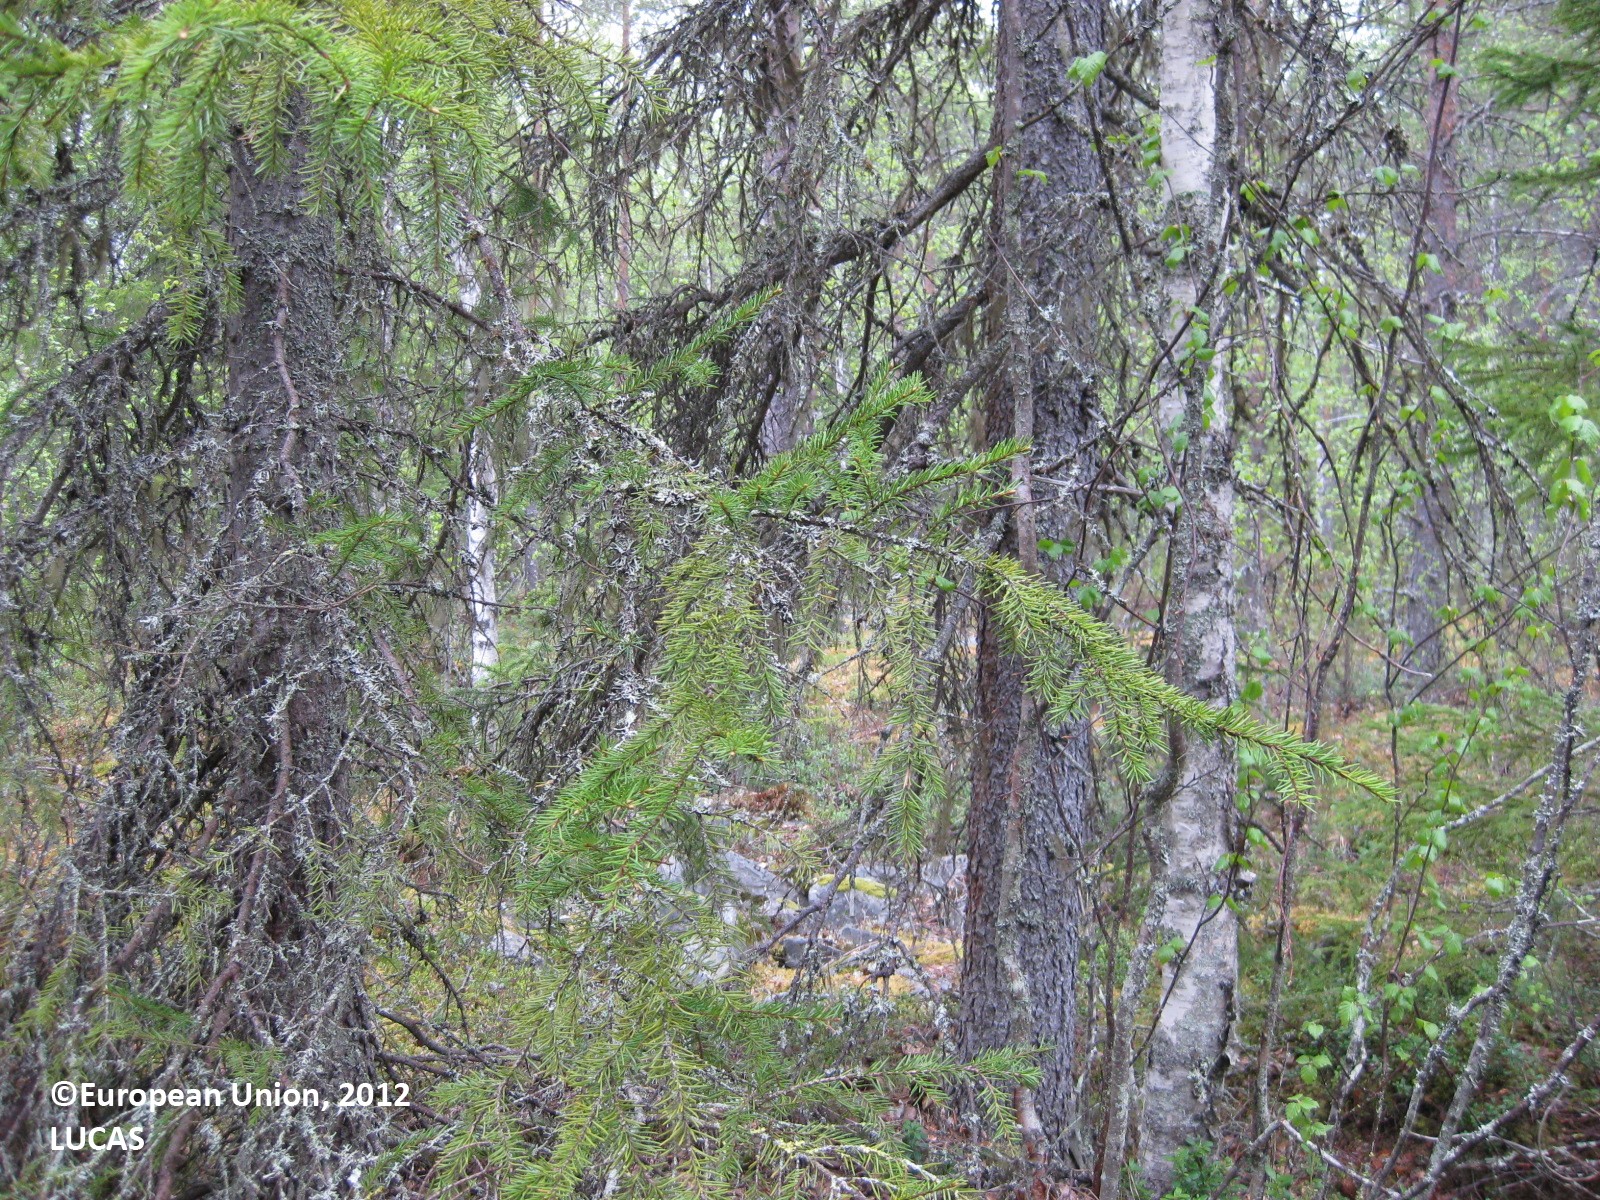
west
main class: Woodland
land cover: Spruce dominated mixed woodland
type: boreal forest
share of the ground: > 75 %
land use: Forestry
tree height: > 5 m
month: June
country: FI
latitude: 65.3277
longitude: 29.3239
